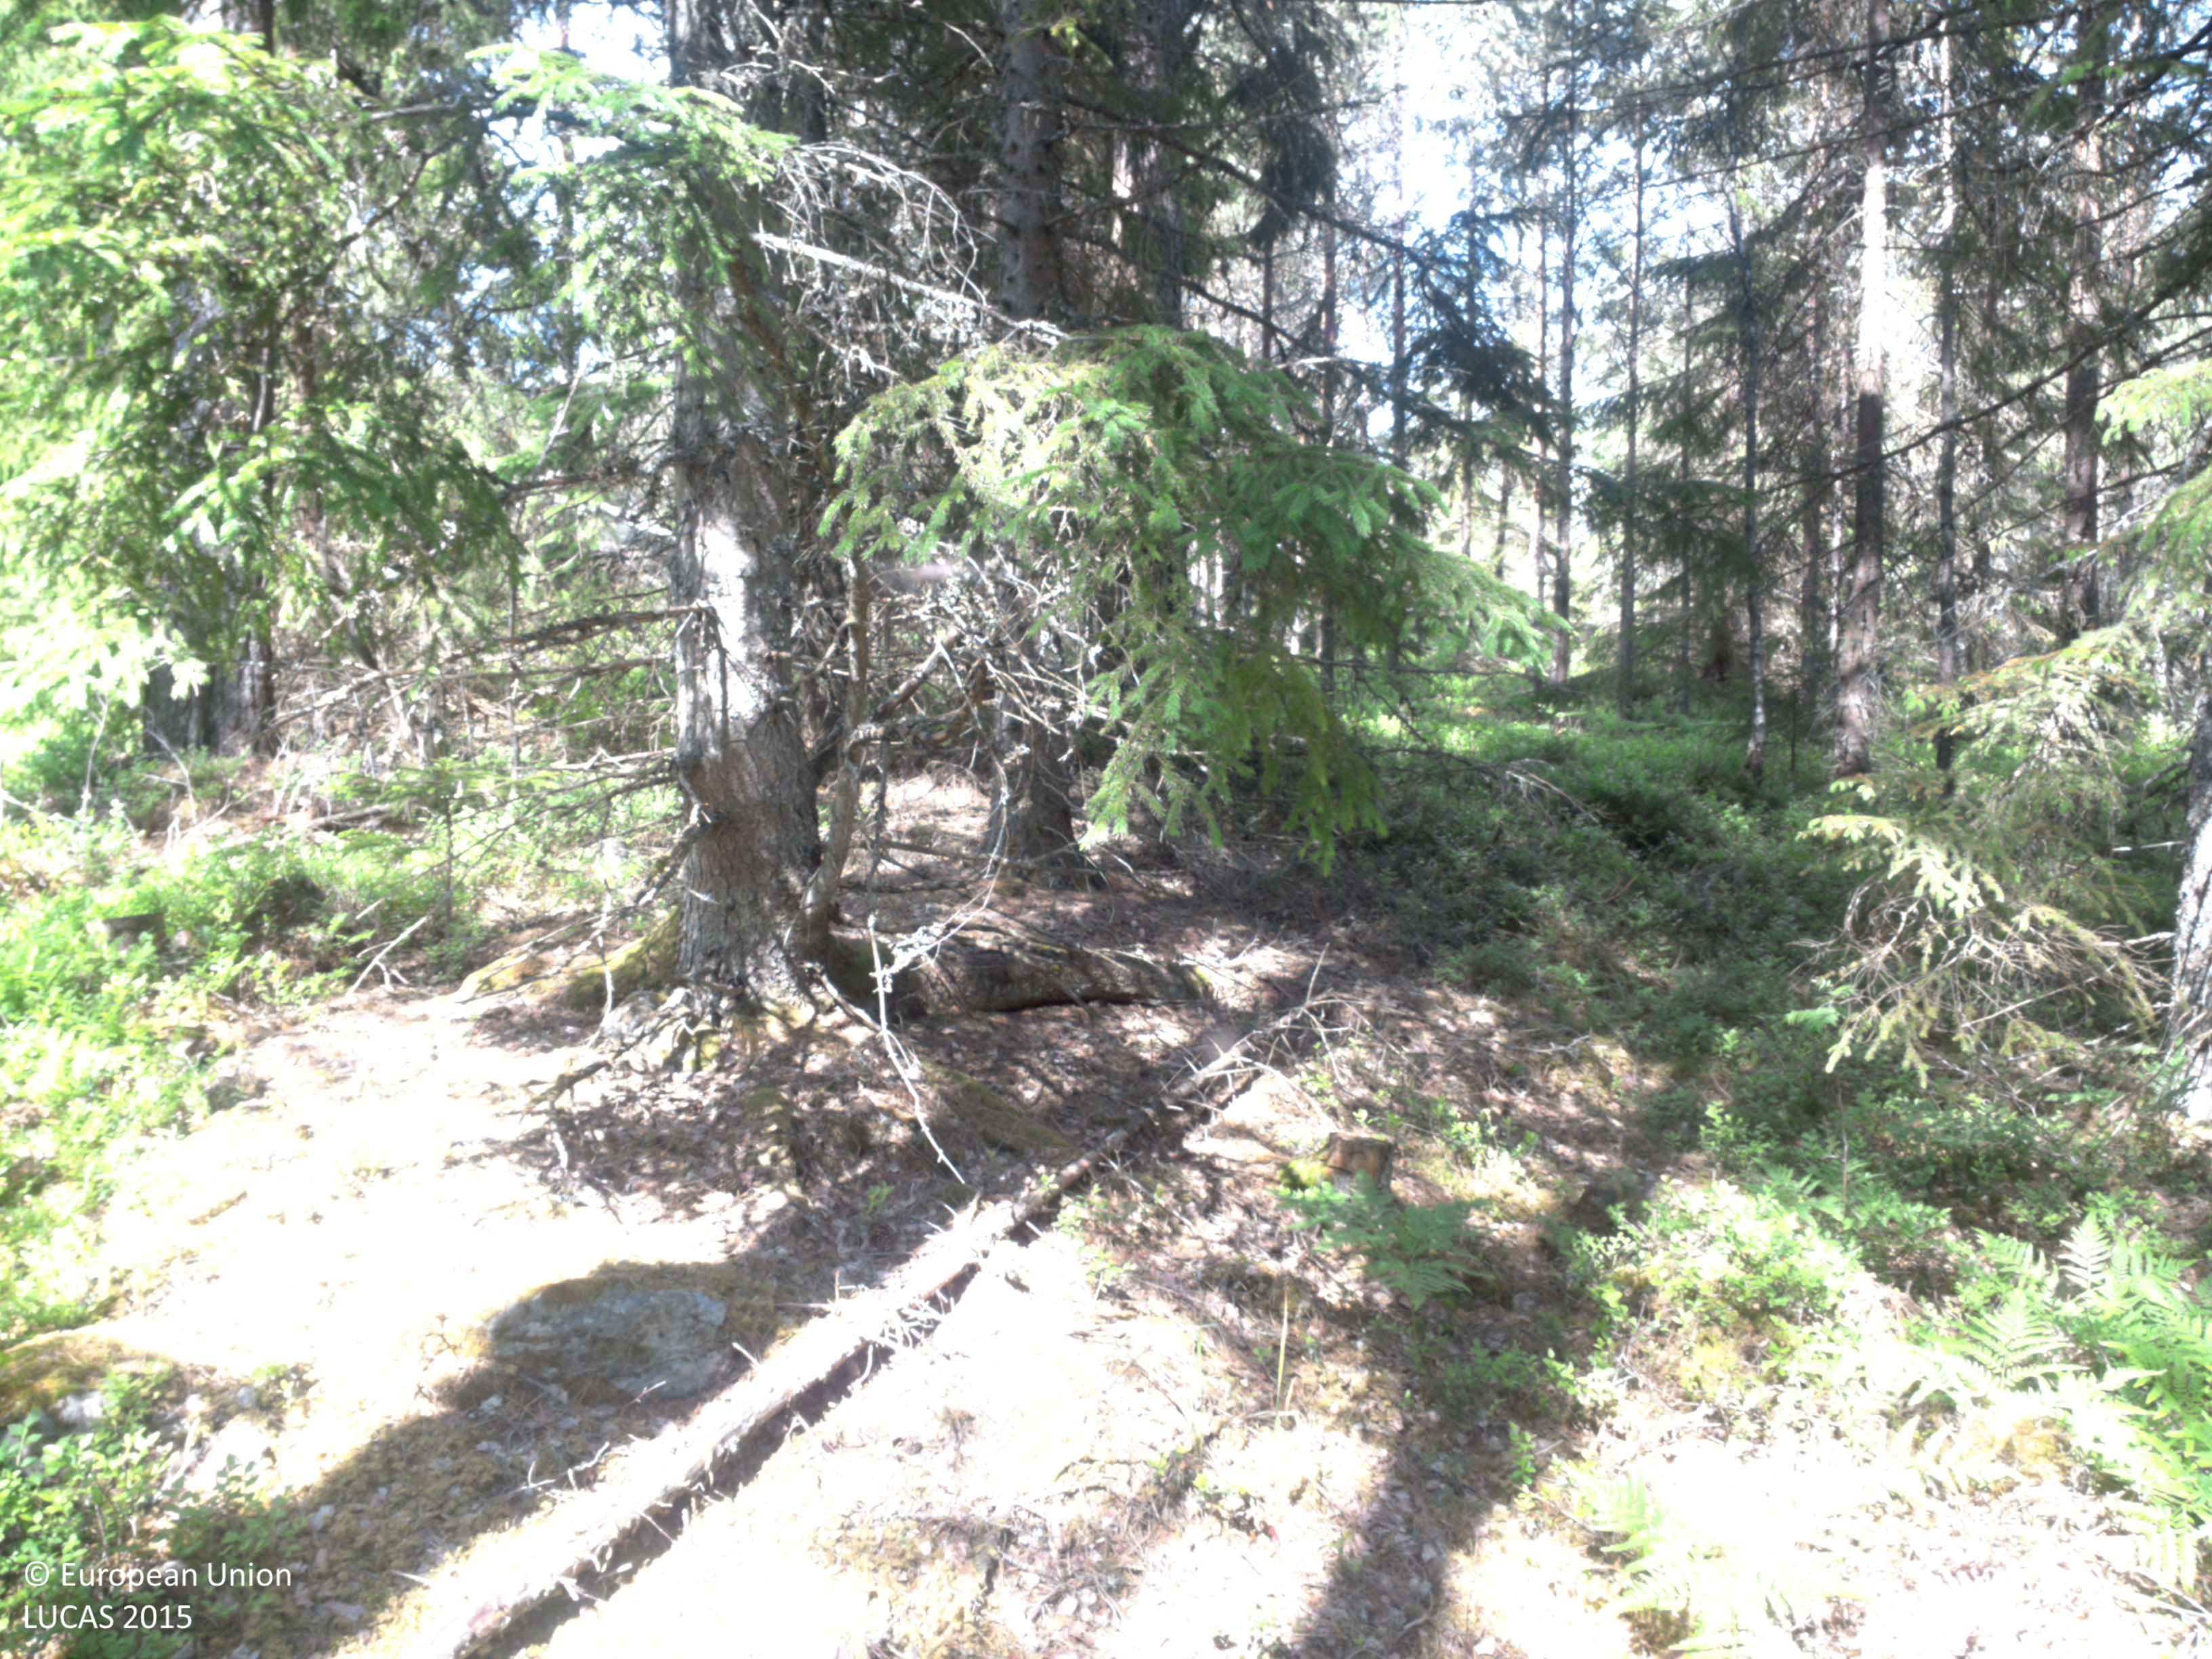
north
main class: Woodland
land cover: Other mixed woodland
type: boreal forest
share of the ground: 50 - 75 %
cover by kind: coniferous forest trees 40 %, herbaceous plants 25 %, broadleaved forest trees 15 %, shrubs 15 %, lichens and mosses 5 %
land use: Forestry
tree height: > 5 m
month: June
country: SE
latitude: 59.0528
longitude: 11.8262
